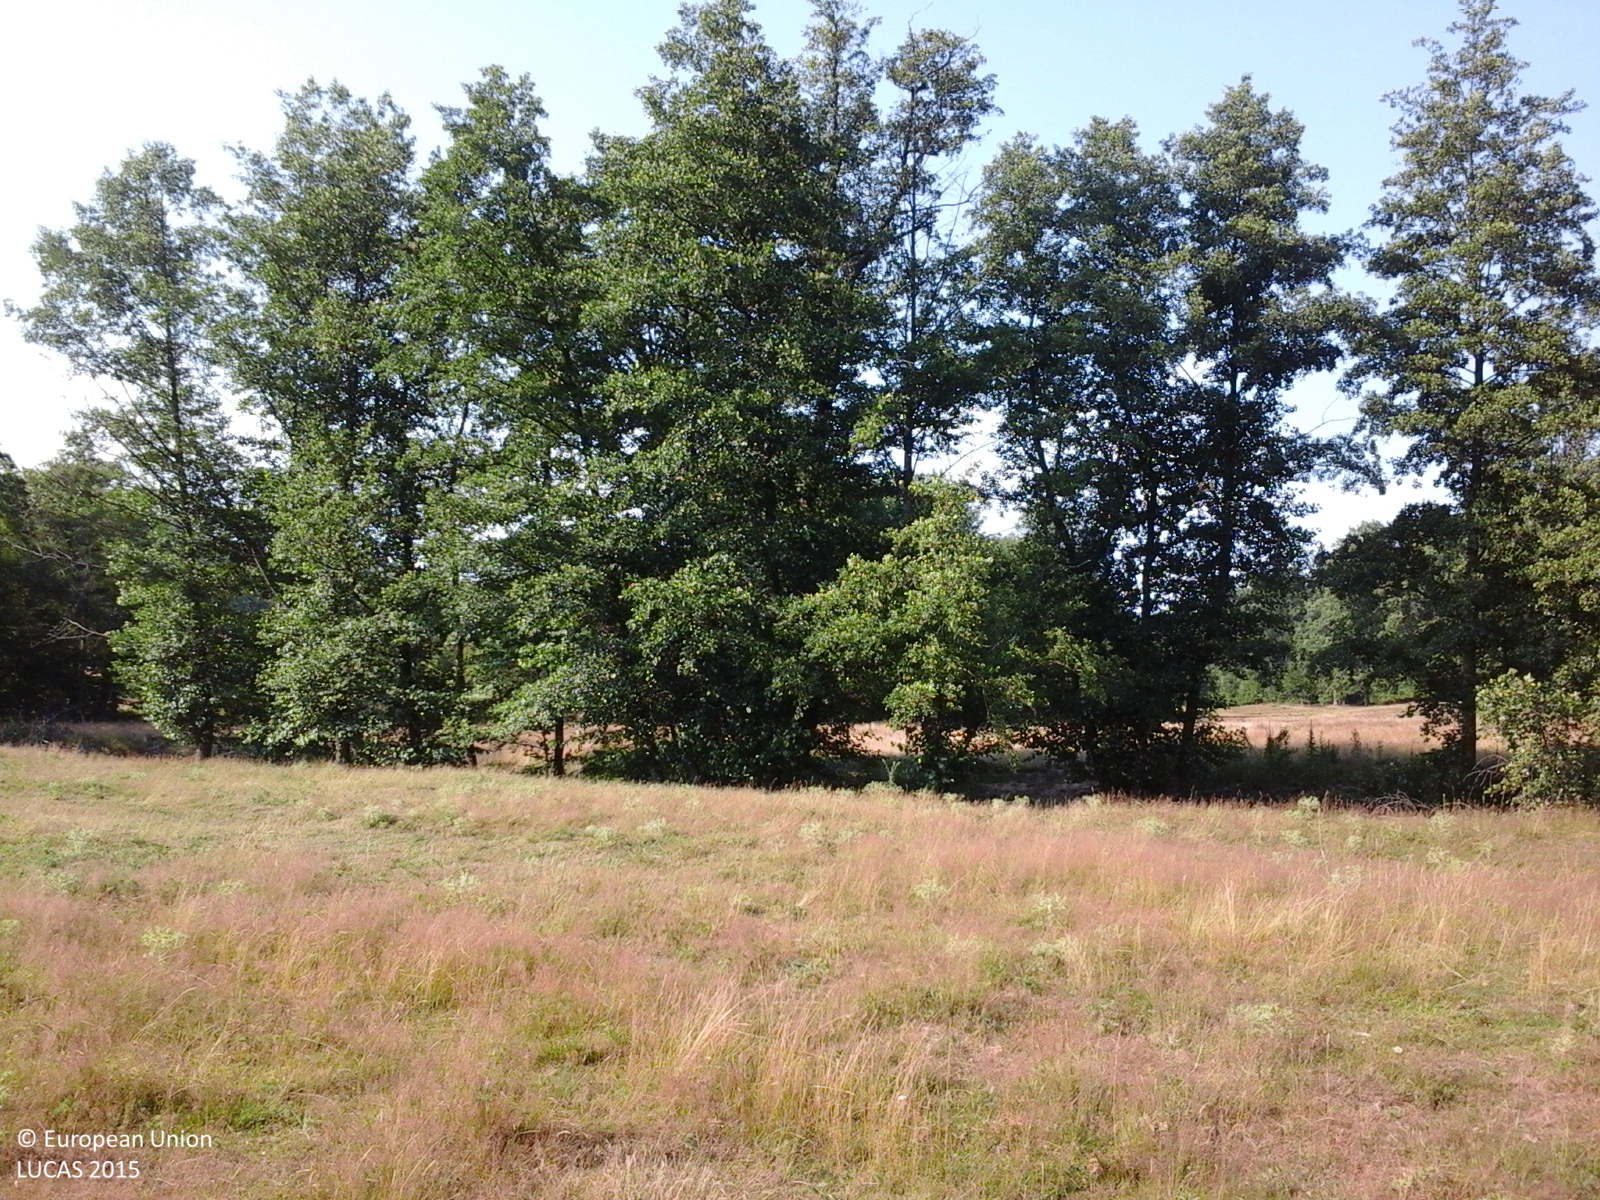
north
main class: Grassland
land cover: Grassland without tree/shrub cover
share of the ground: > 75 %
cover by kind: herbaceous plants 100 %
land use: Agriculture (excluding fallow land and kitchen gardens)
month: July
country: RO
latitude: 44.9349
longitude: 24.5079
